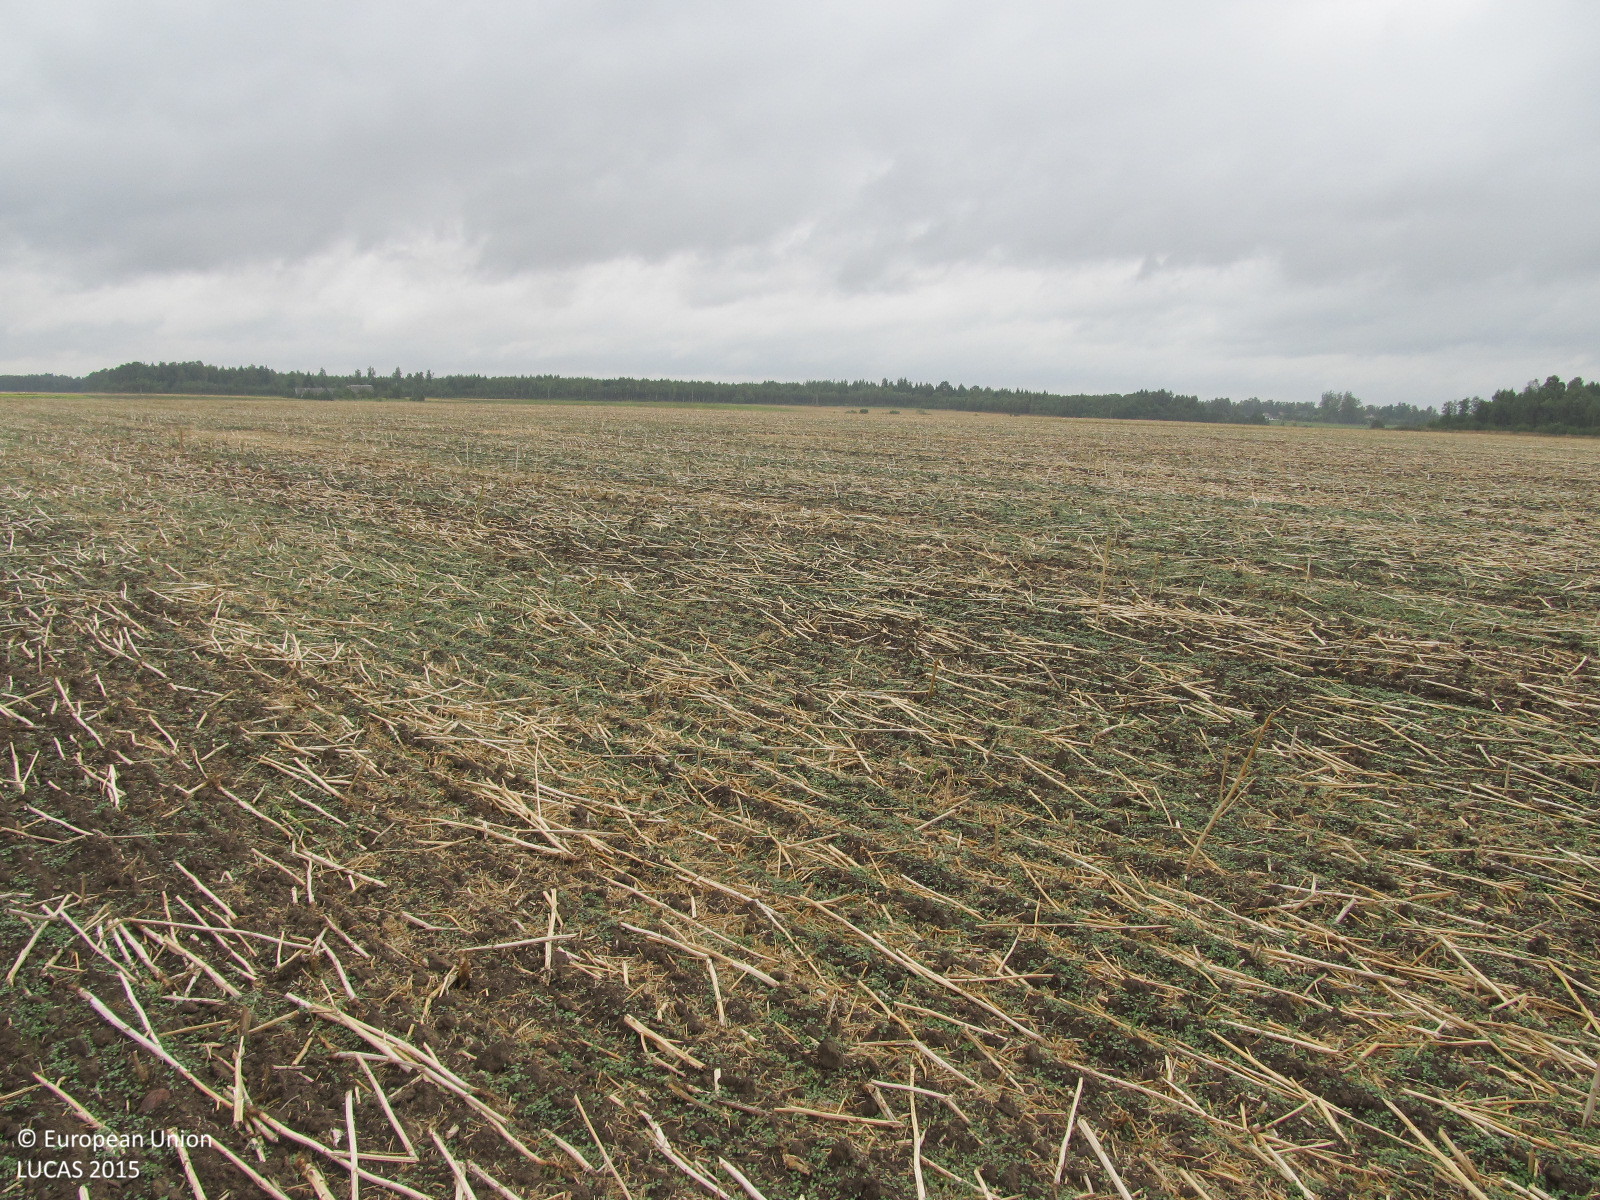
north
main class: Cropland
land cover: Rape and turnip rape
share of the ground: 25 - 50 %
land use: Agriculture (excluding fallow land and kitchen gardens)
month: August
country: LT
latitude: 55.9689
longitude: 23.0954
